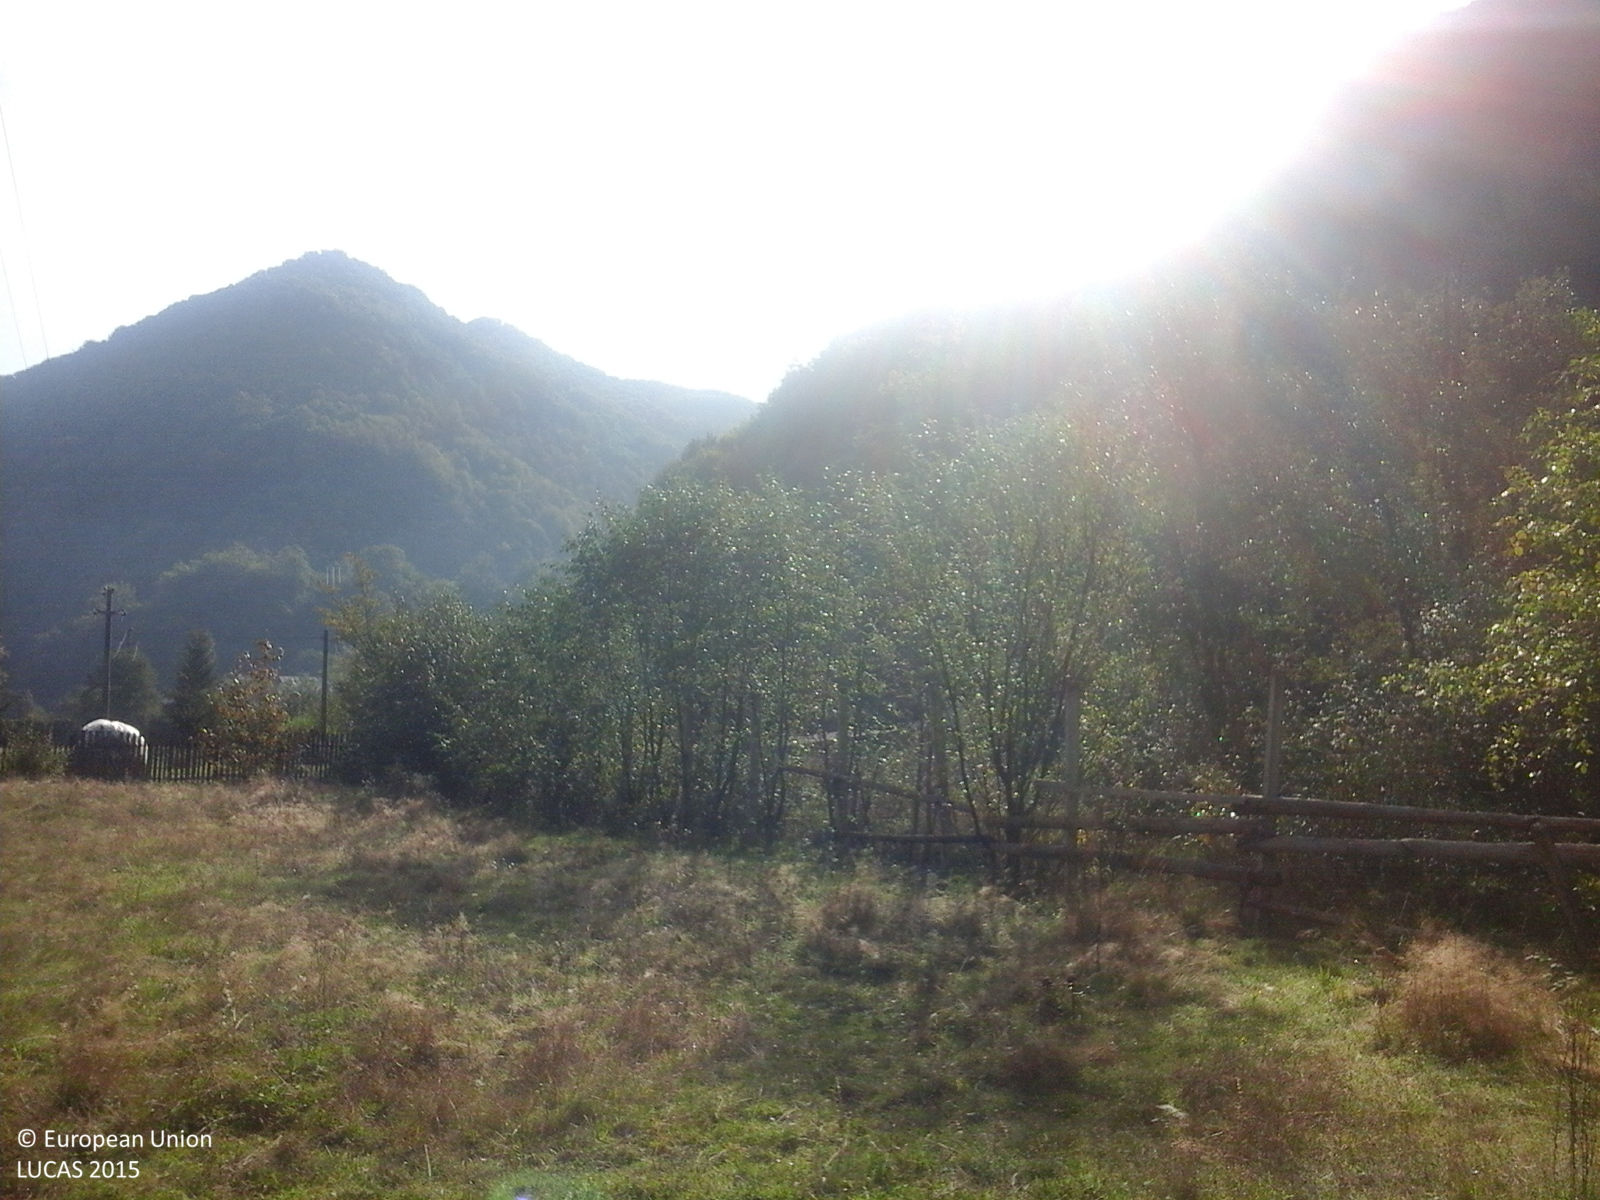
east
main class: Grassland
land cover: Grassland without tree/shrub cover
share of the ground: > 75 %
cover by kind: herbaceous plants 100 %
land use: Agriculture (excluding fallow land and kitchen gardens)
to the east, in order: Grassland without tree/shrub cover; Artificial constructions in urban areas; Inland fresh running water
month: September
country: RO
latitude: 46.6858
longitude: 23.2838
